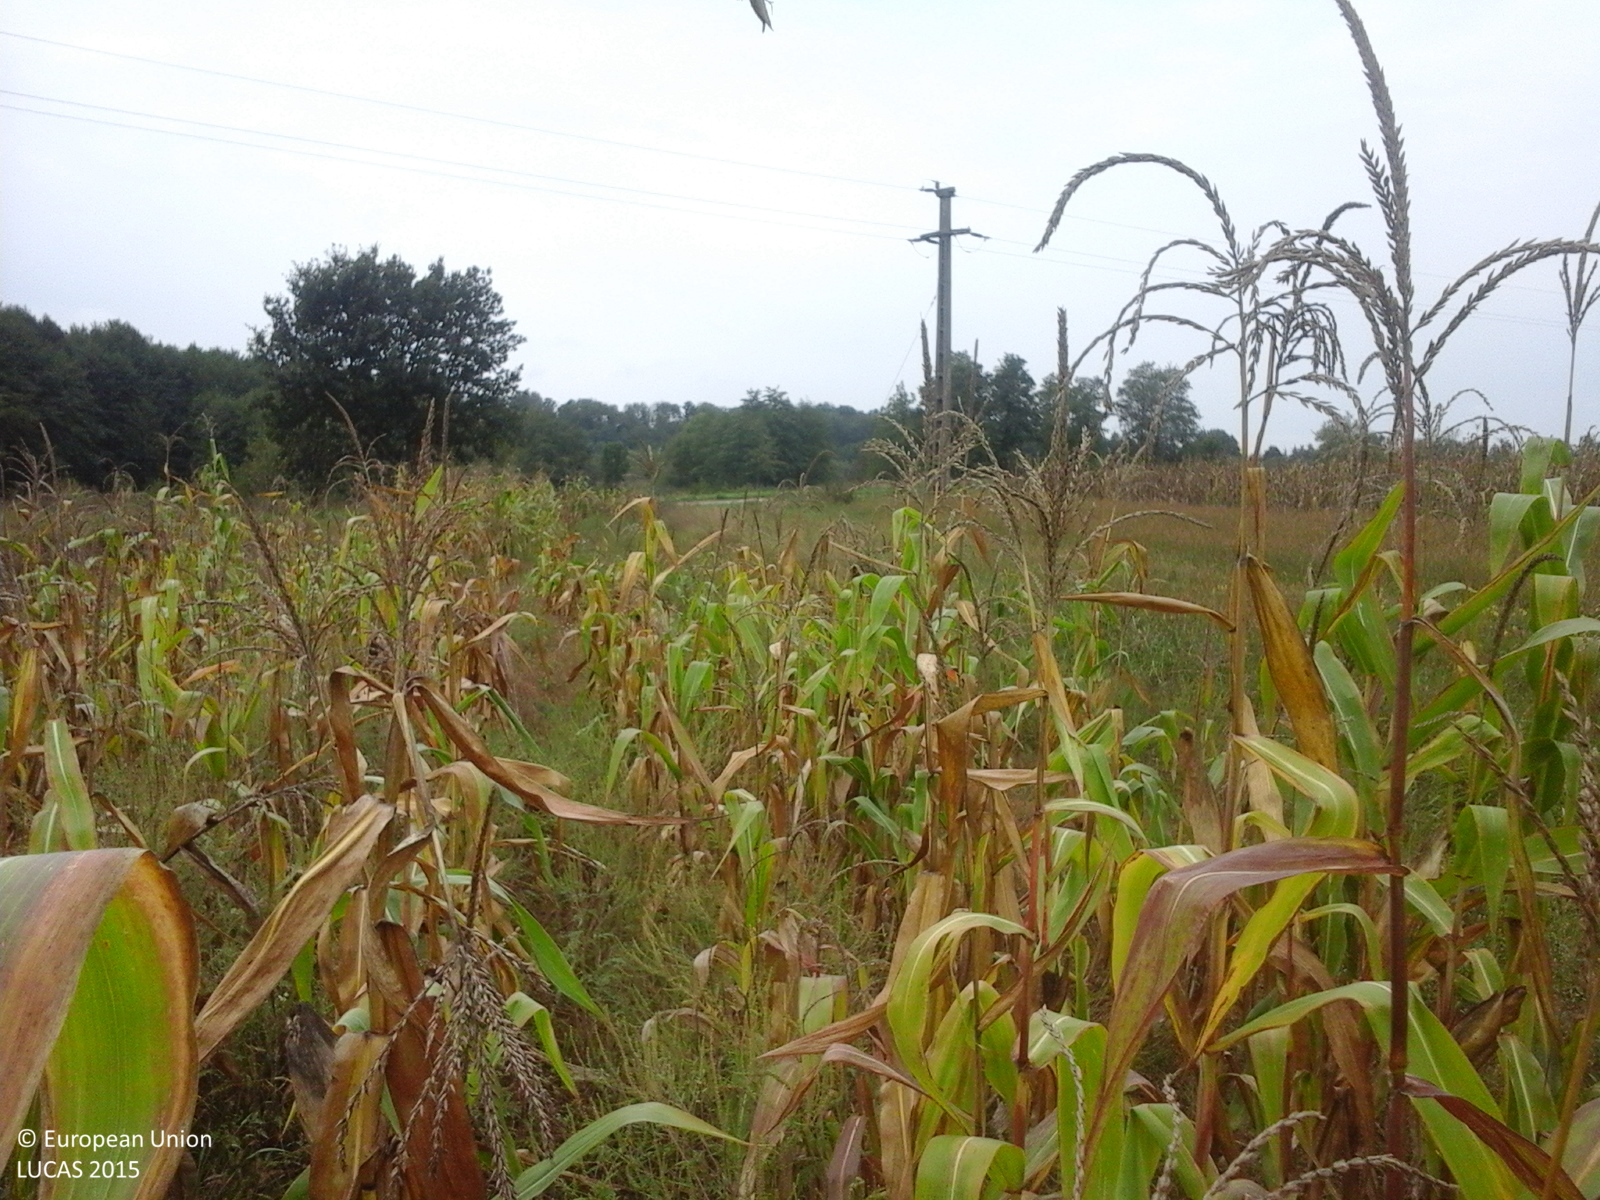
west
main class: Cropland
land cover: Maize
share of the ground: > 75 %
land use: Agriculture (excluding fallow land and kitchen gardens)
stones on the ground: < 10 %
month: September
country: RO
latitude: 45.8280
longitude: 22.2340
